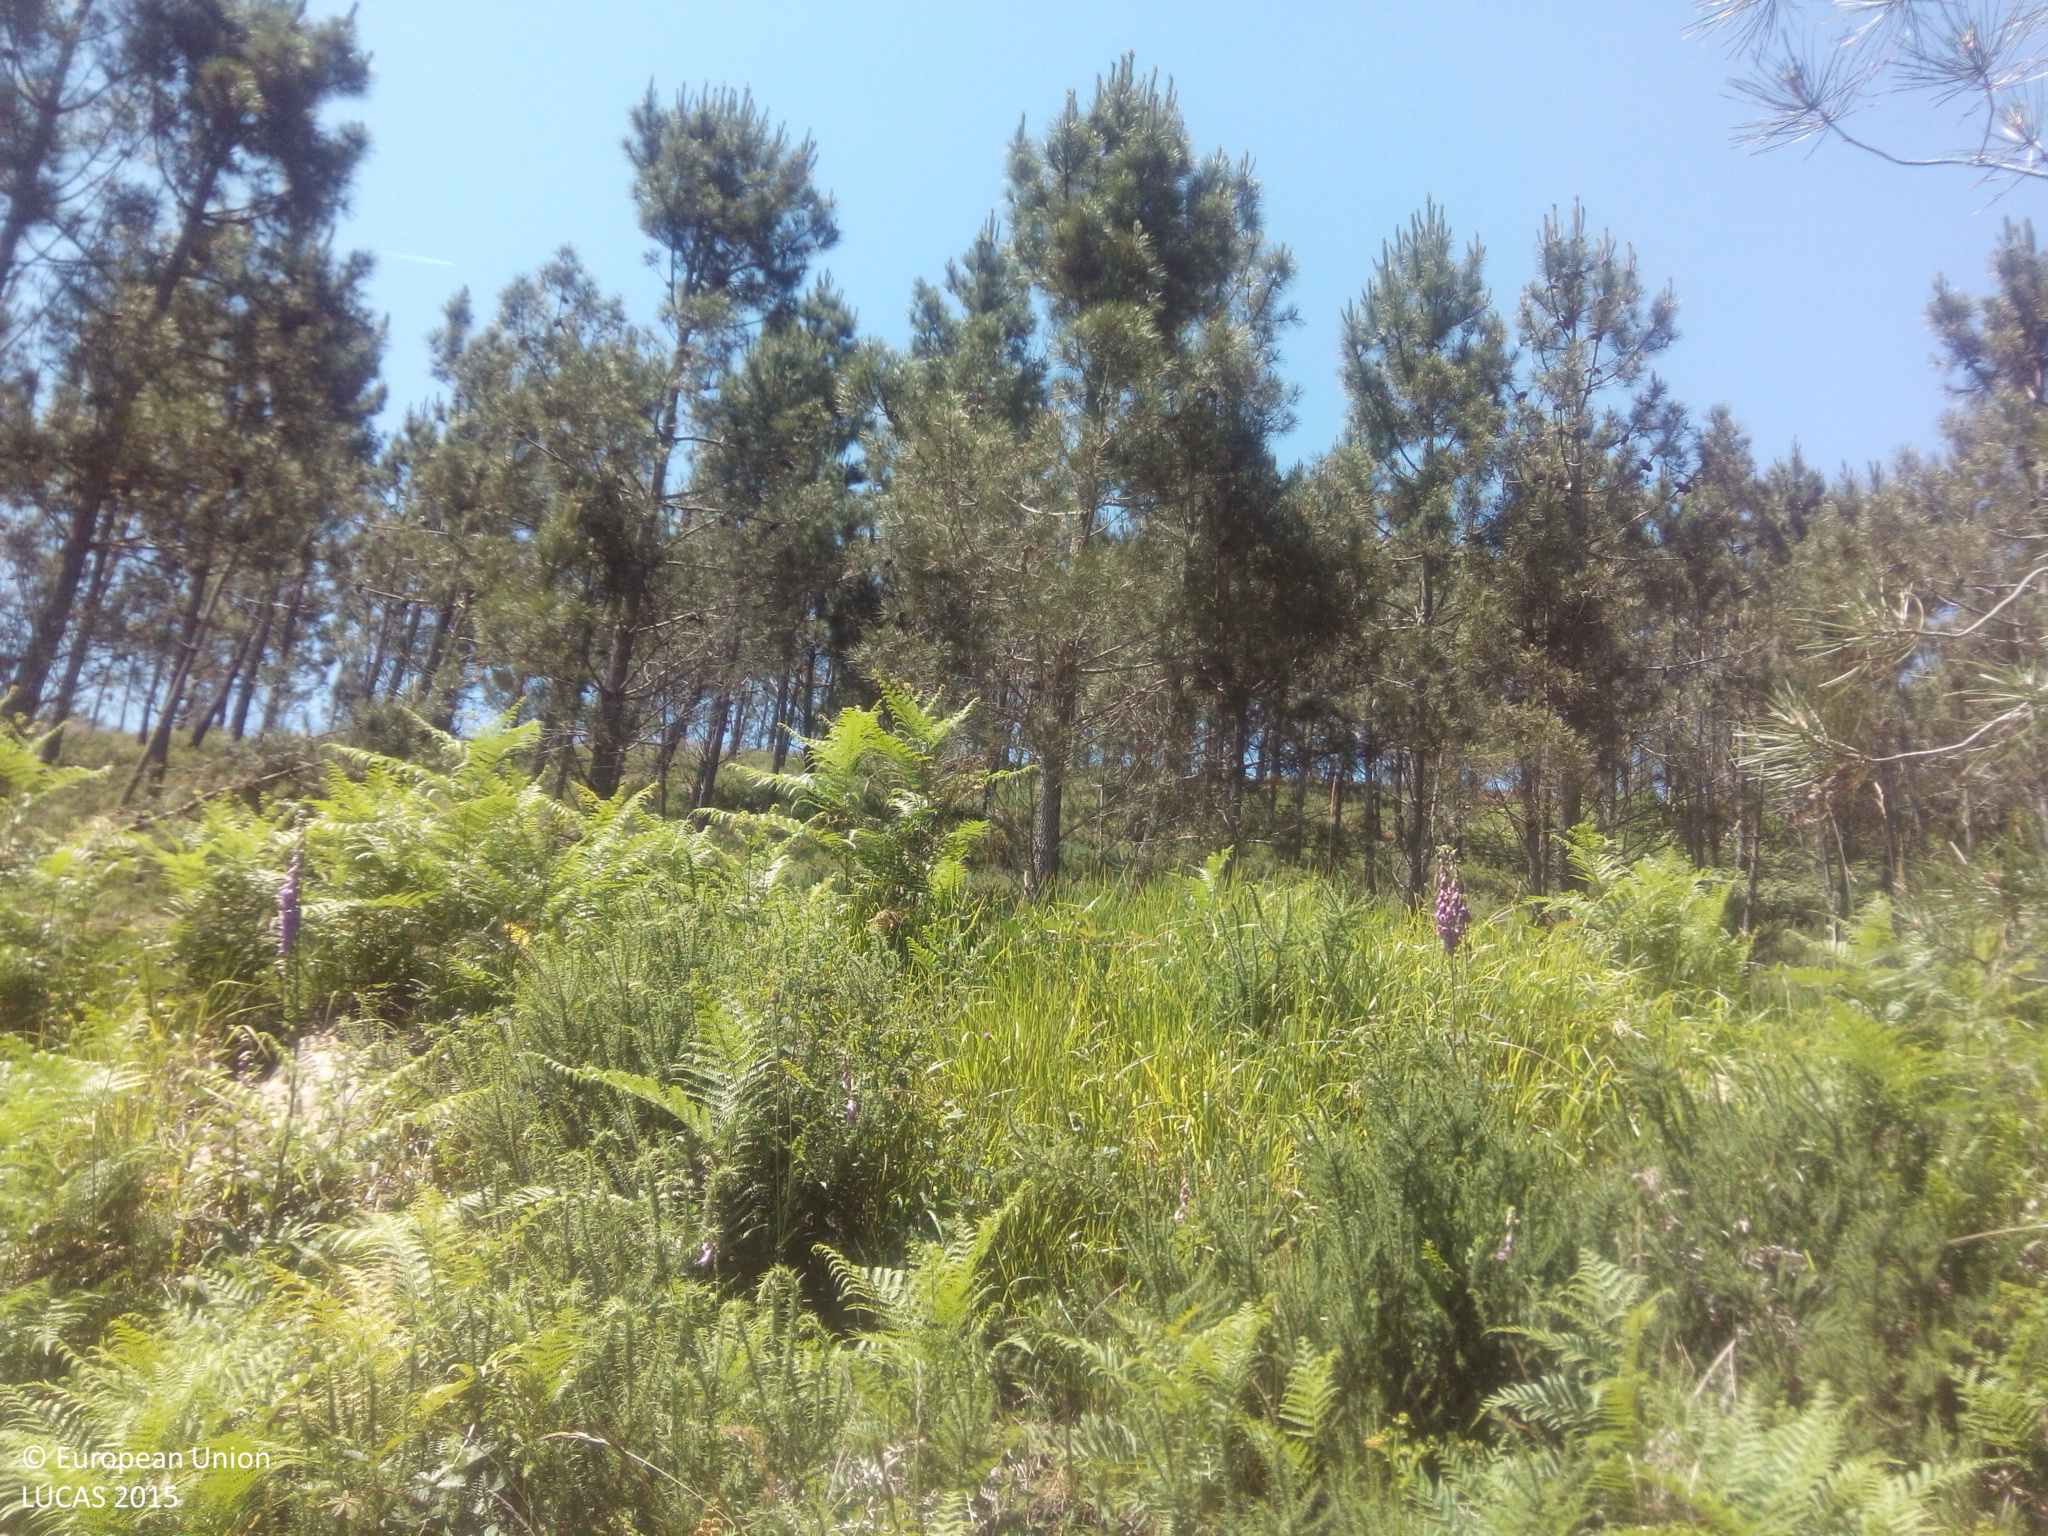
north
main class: Woodland
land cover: Pine dominated coniferous woodland
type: hemiboreal forest and nemoral coniferous forest and mixed broadleaved-coniferous forest
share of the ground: > 75 %
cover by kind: coniferous forest trees 60 %, shrubs 25 %, herbaceous plants 15 %
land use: Forestry
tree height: > 5 m
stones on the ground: < 10 %
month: June
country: ES
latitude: 42.4663
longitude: -8.2980
